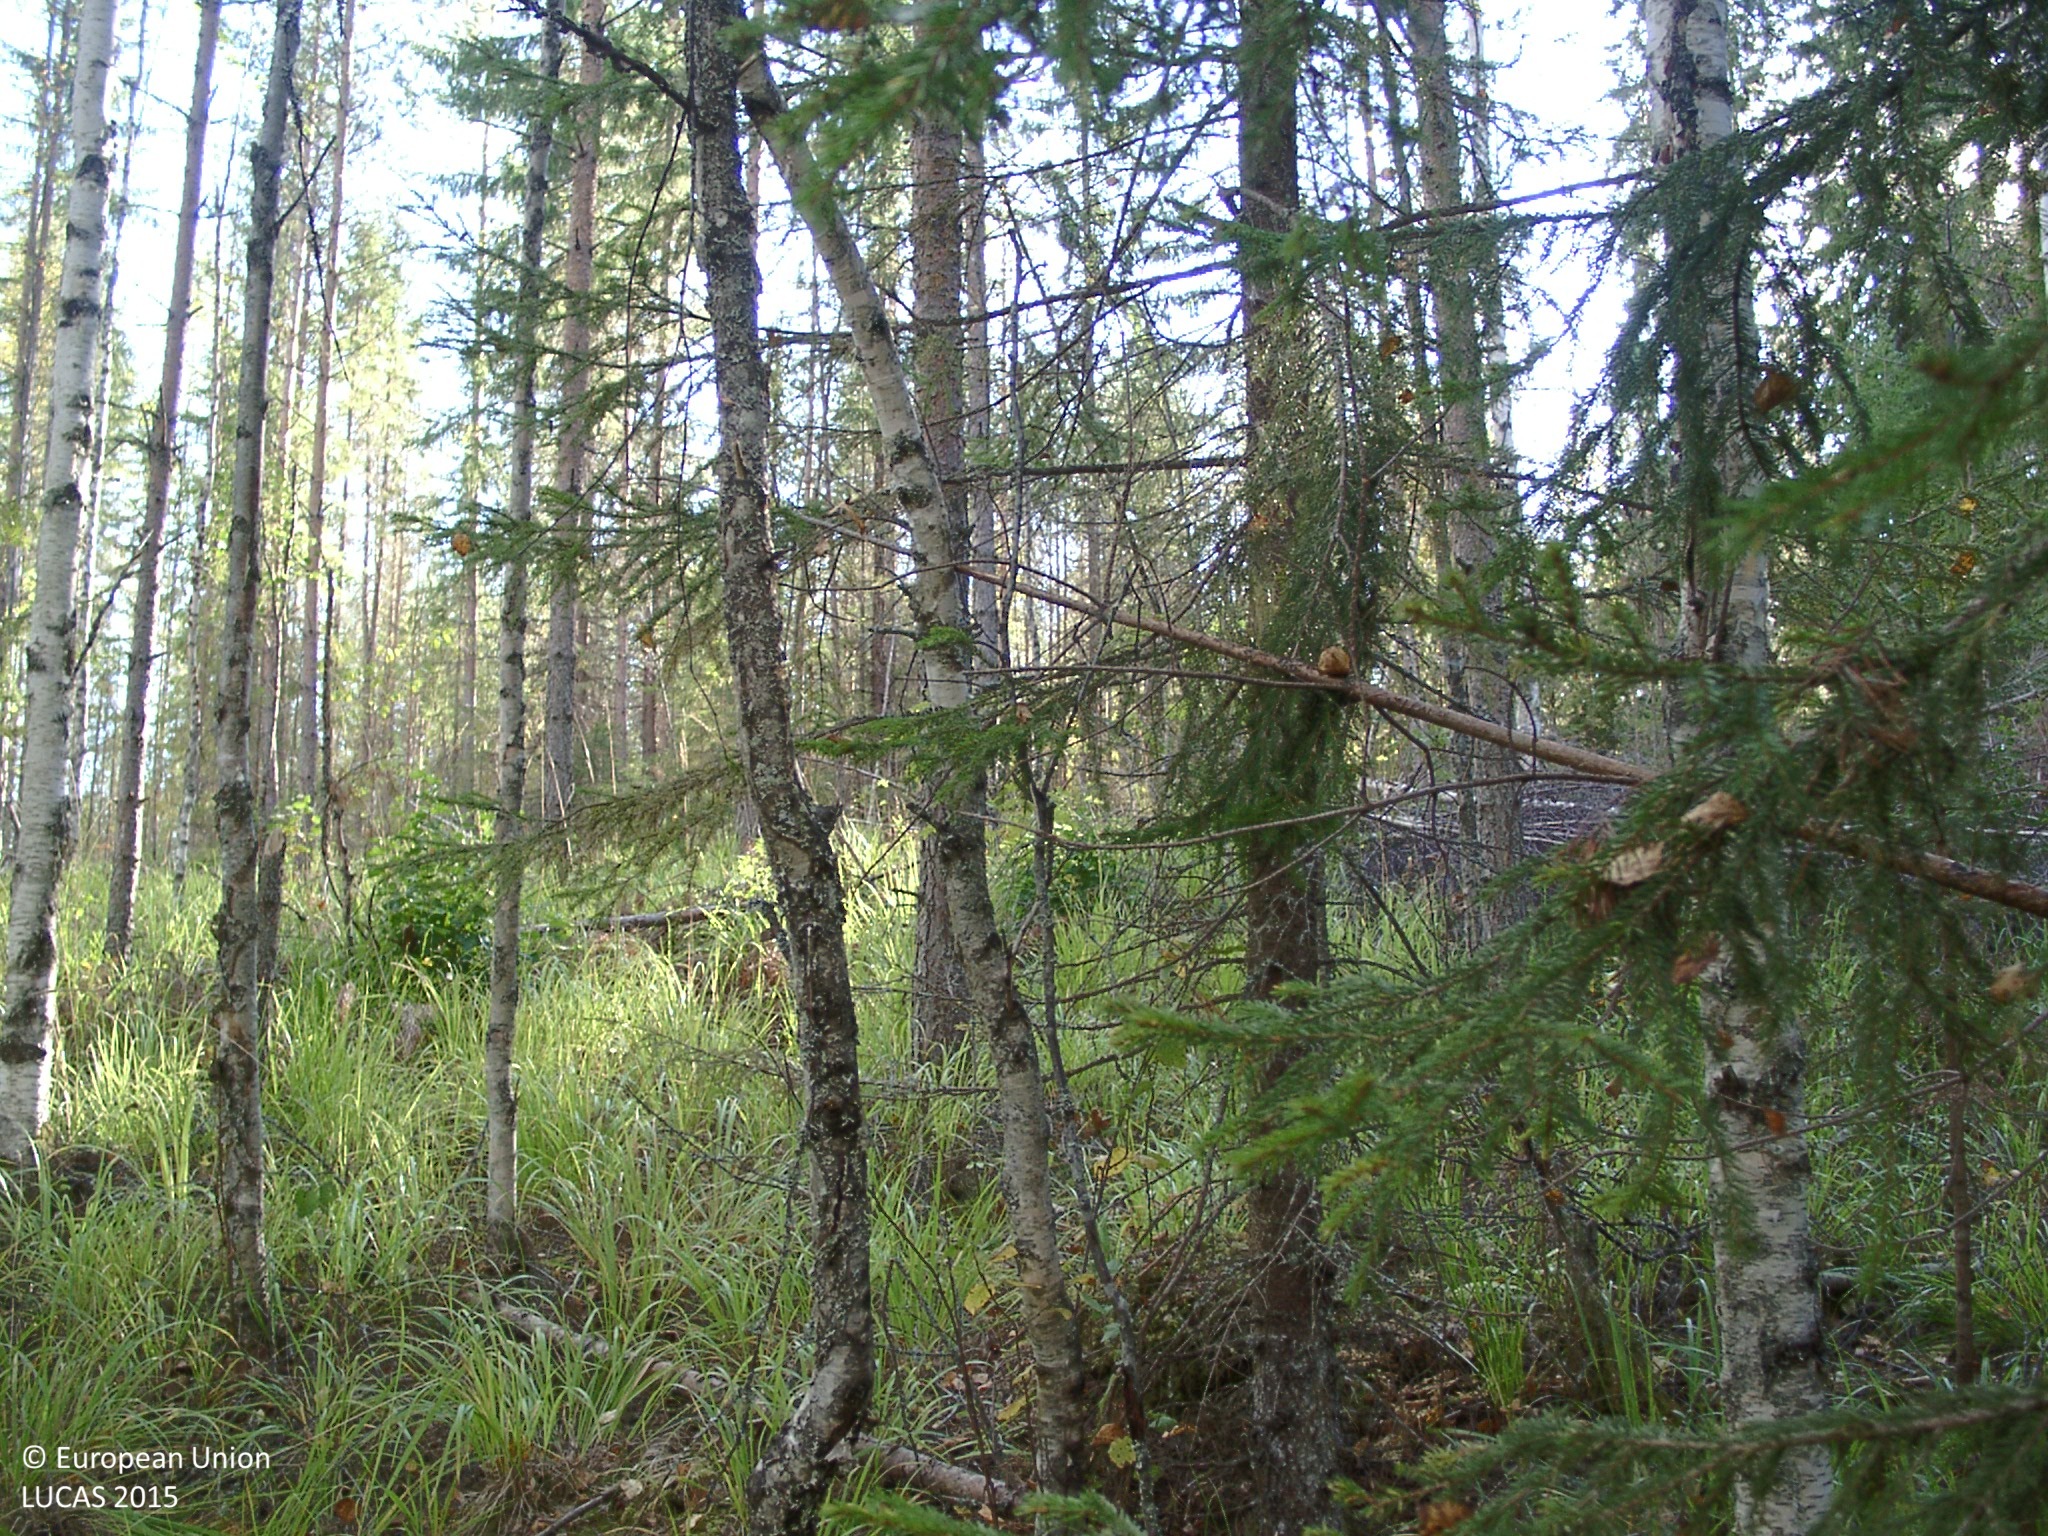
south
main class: Woodland
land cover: Pine dominated mixed woodland
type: boreal forest
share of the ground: 50 - 75 %
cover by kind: coniferous forest trees 30 %, broadleaved forest trees 30 %, herbaceous plants 25 %, lichens and mosses 10 %
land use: Forestry
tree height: > 5 m
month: September
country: FI
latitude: 62.5256
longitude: 25.6388
